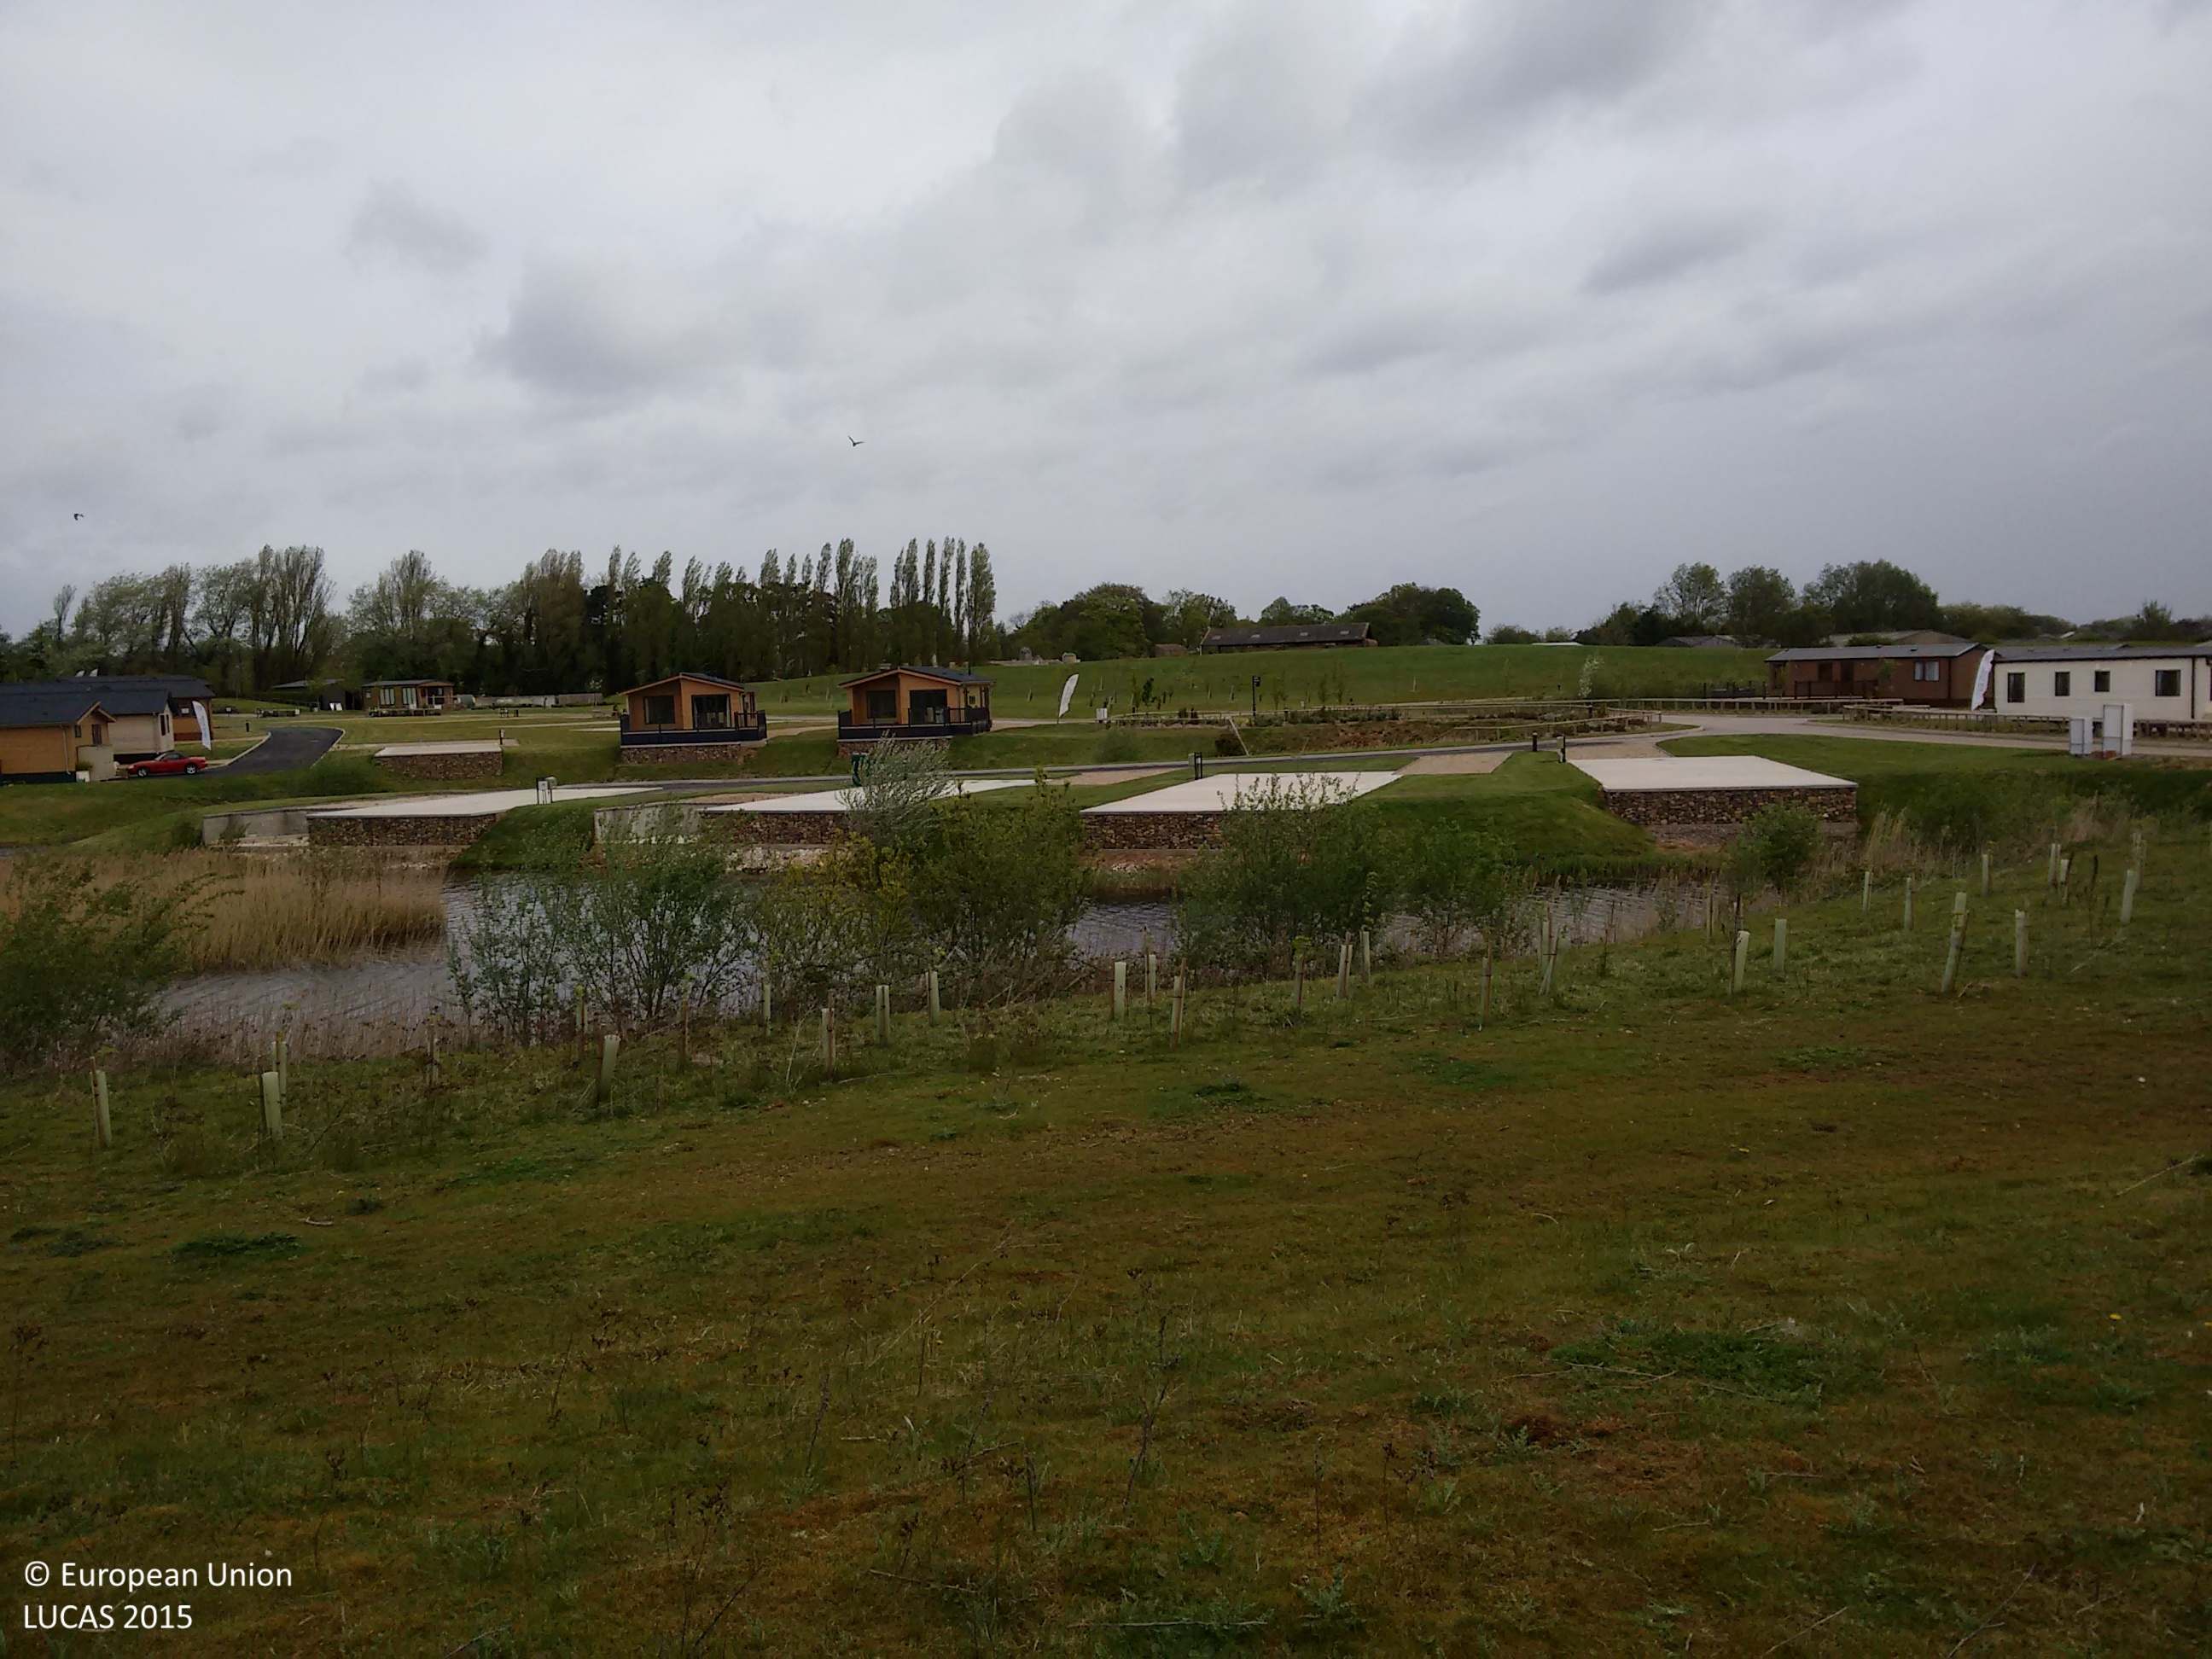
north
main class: Grassland
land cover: Grassland without tree/shrub cover
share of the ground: > 75 %
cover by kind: herbaceous plants 100 %
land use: Amenities, museums, leisure
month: May
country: GB
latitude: 53.9036
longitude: -0.3083
